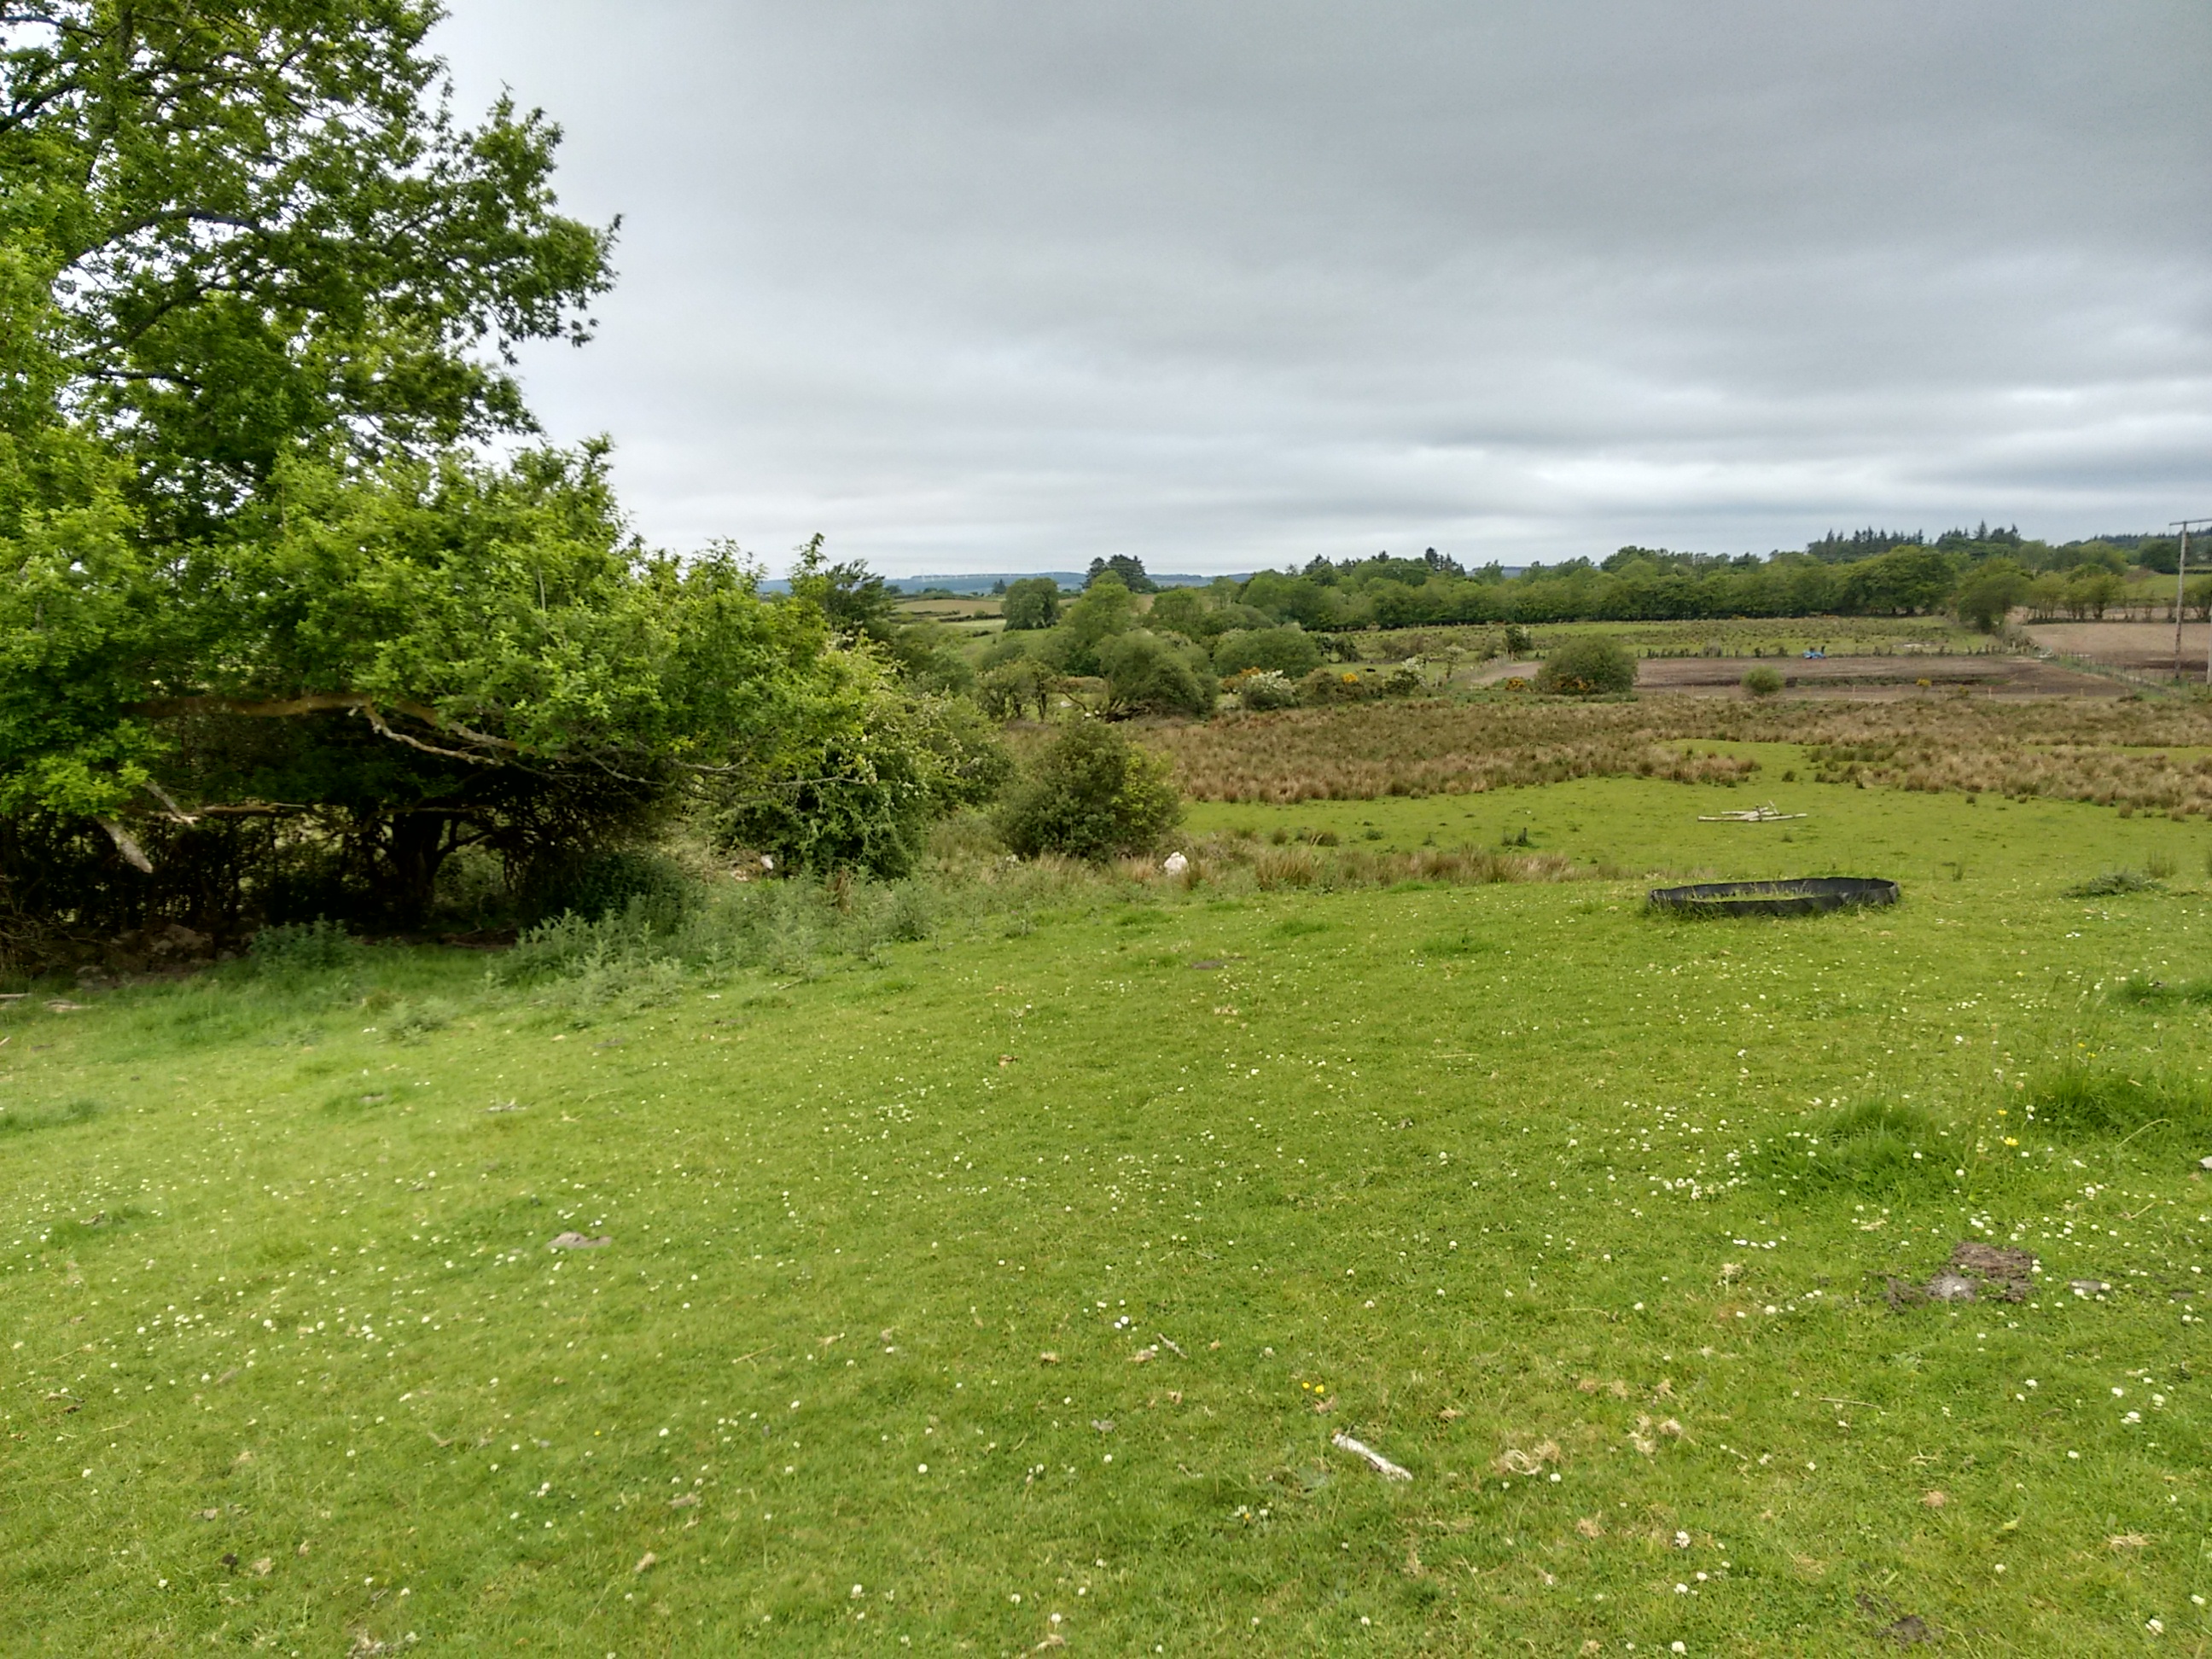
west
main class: Grassland
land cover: Grassland with sparse tree/shrub cover
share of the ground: > 75 %
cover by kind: herbaceous plants 85 %, shrubs 10 %, broadleaved forest trees 5 %
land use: Agriculture (excluding fallow land and kitchen gardens)
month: June
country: IE
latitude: 53.0701
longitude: -8.4757
